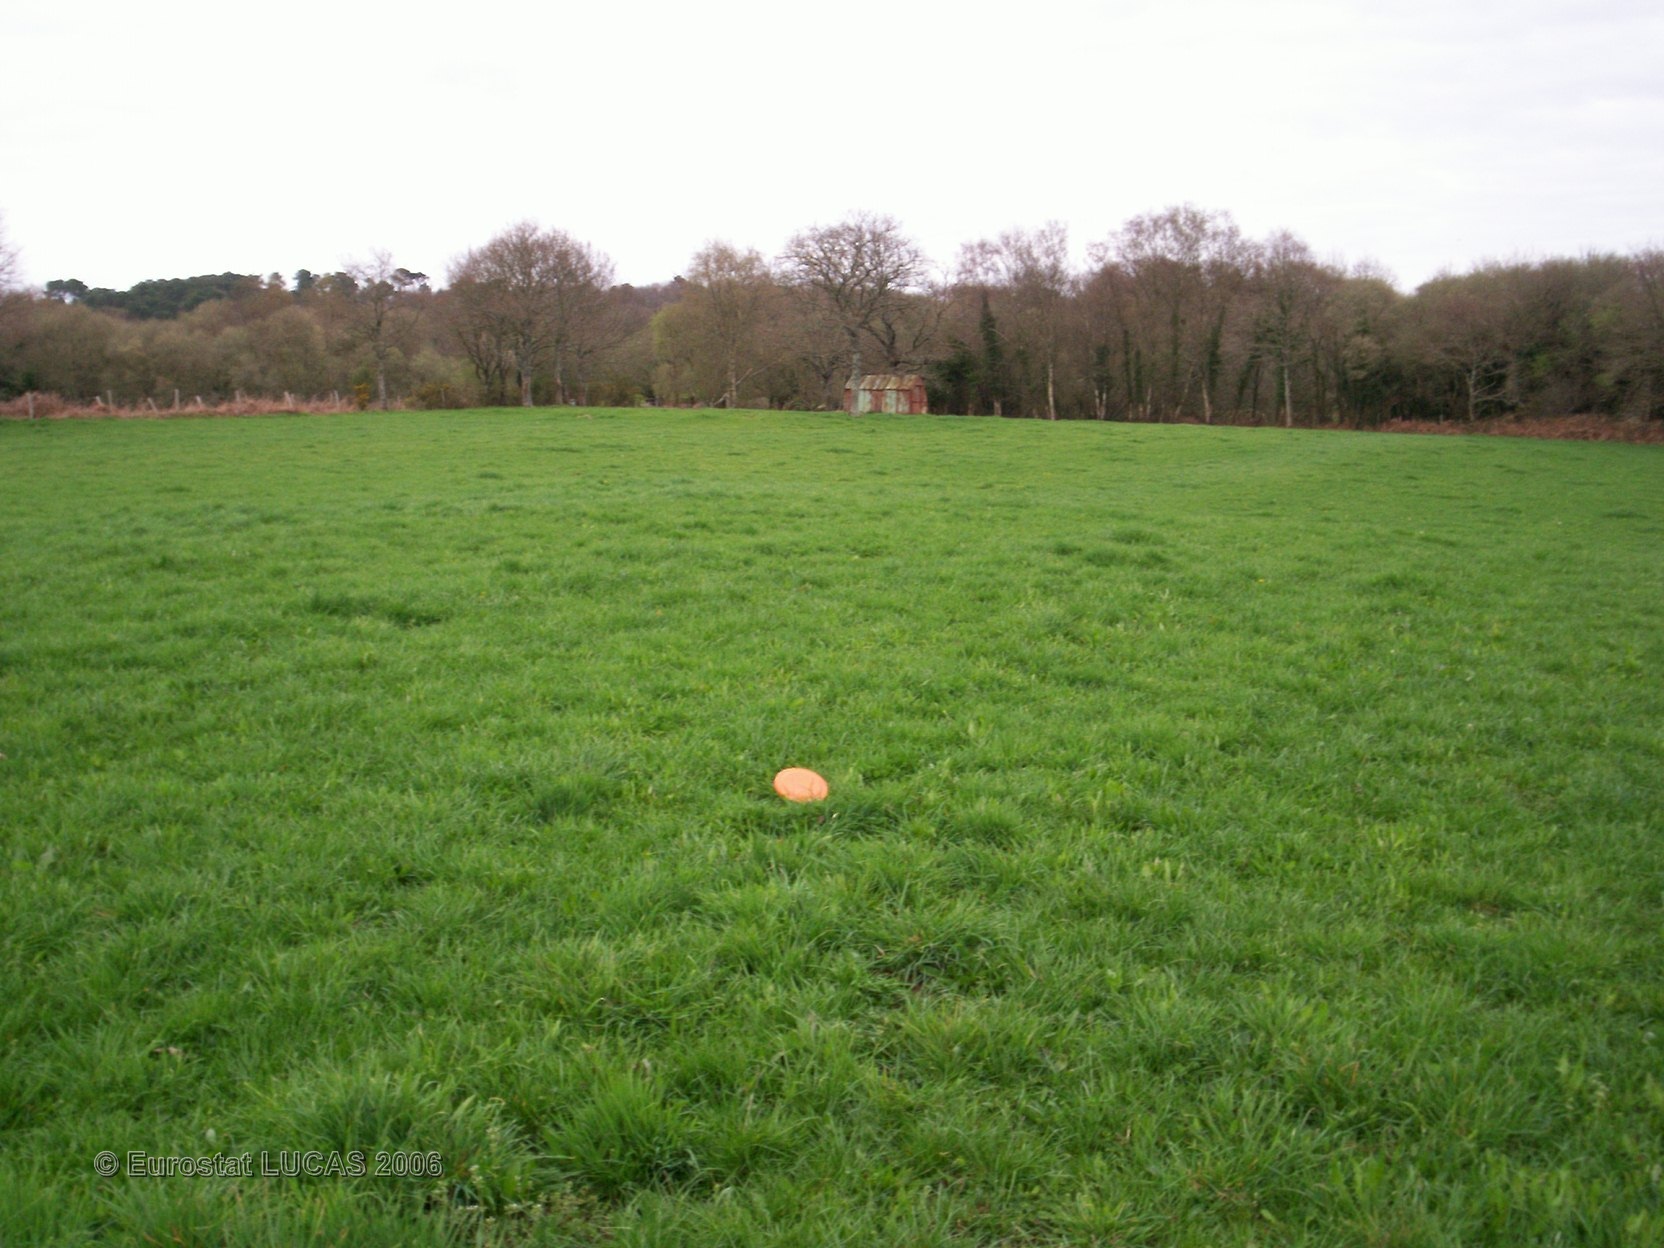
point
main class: Grassland
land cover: Grassland without tree/shrub cover
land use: Agriculture (excluding fallow land and kitchen gardens)
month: April
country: FR
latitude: 47.8085
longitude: -3.4957
